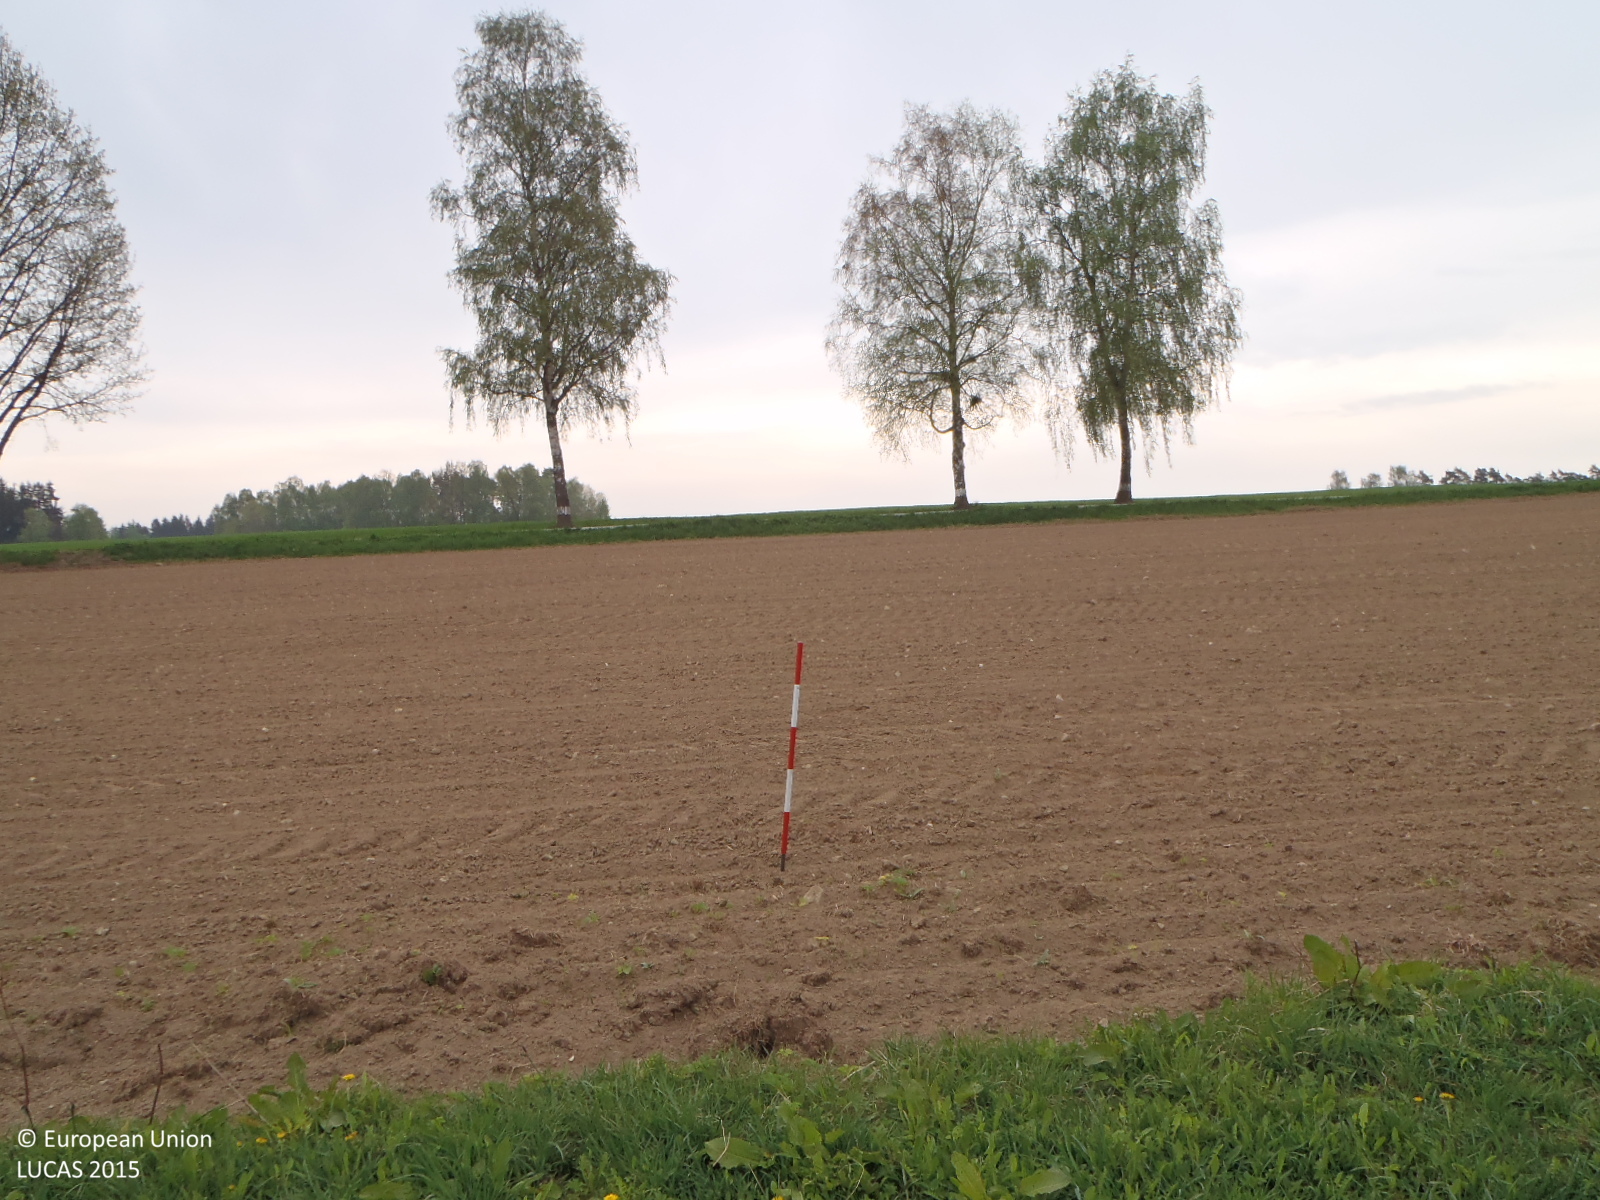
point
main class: Cropland
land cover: Maize
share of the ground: < 10 %
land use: Agriculture (excluding fallow land and kitchen gardens)
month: May
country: CZ
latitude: 49.2221
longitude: 15.1239
